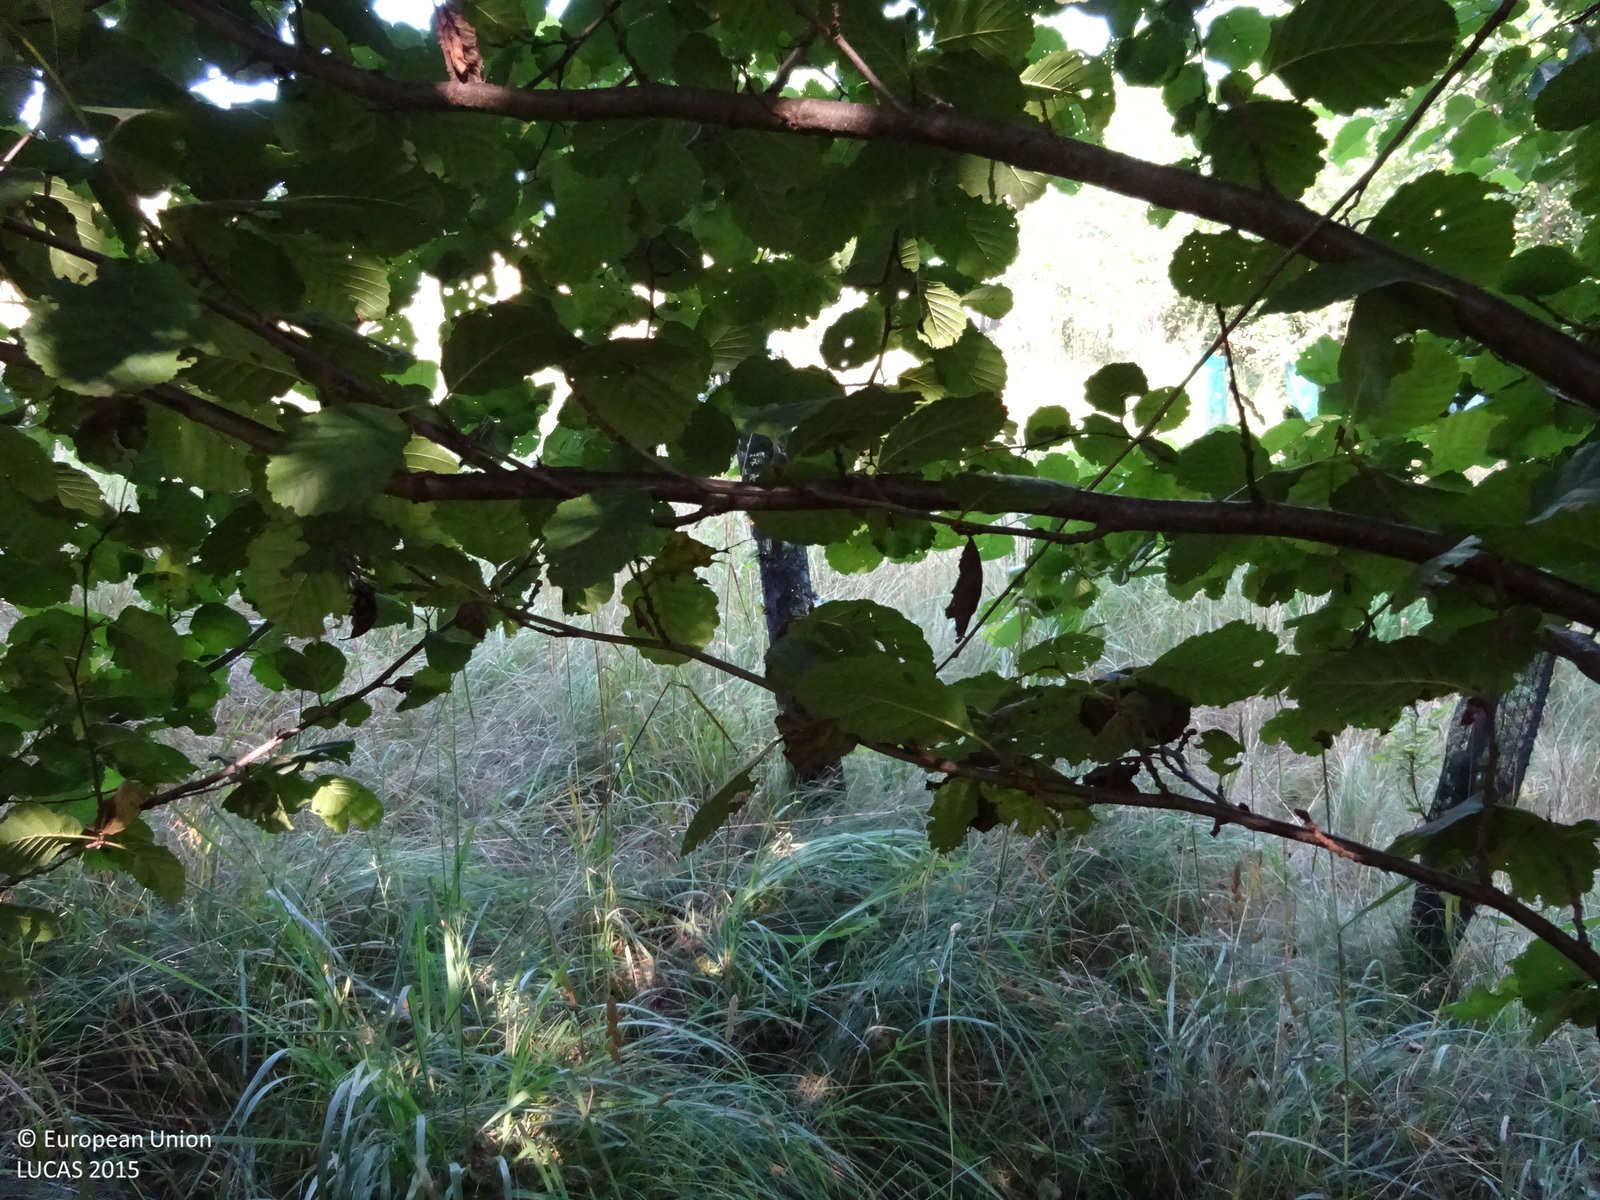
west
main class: Woodland
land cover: Broadleaved woodland
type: hemiboreal forest and nemoral coniferous forest and mixed broadleaved-coniferous forest
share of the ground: > 75 %
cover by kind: broadleaved forest trees 100 %
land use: Forestry
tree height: > 5 m
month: July
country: AT
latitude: 46.8790
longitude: 15.4712
